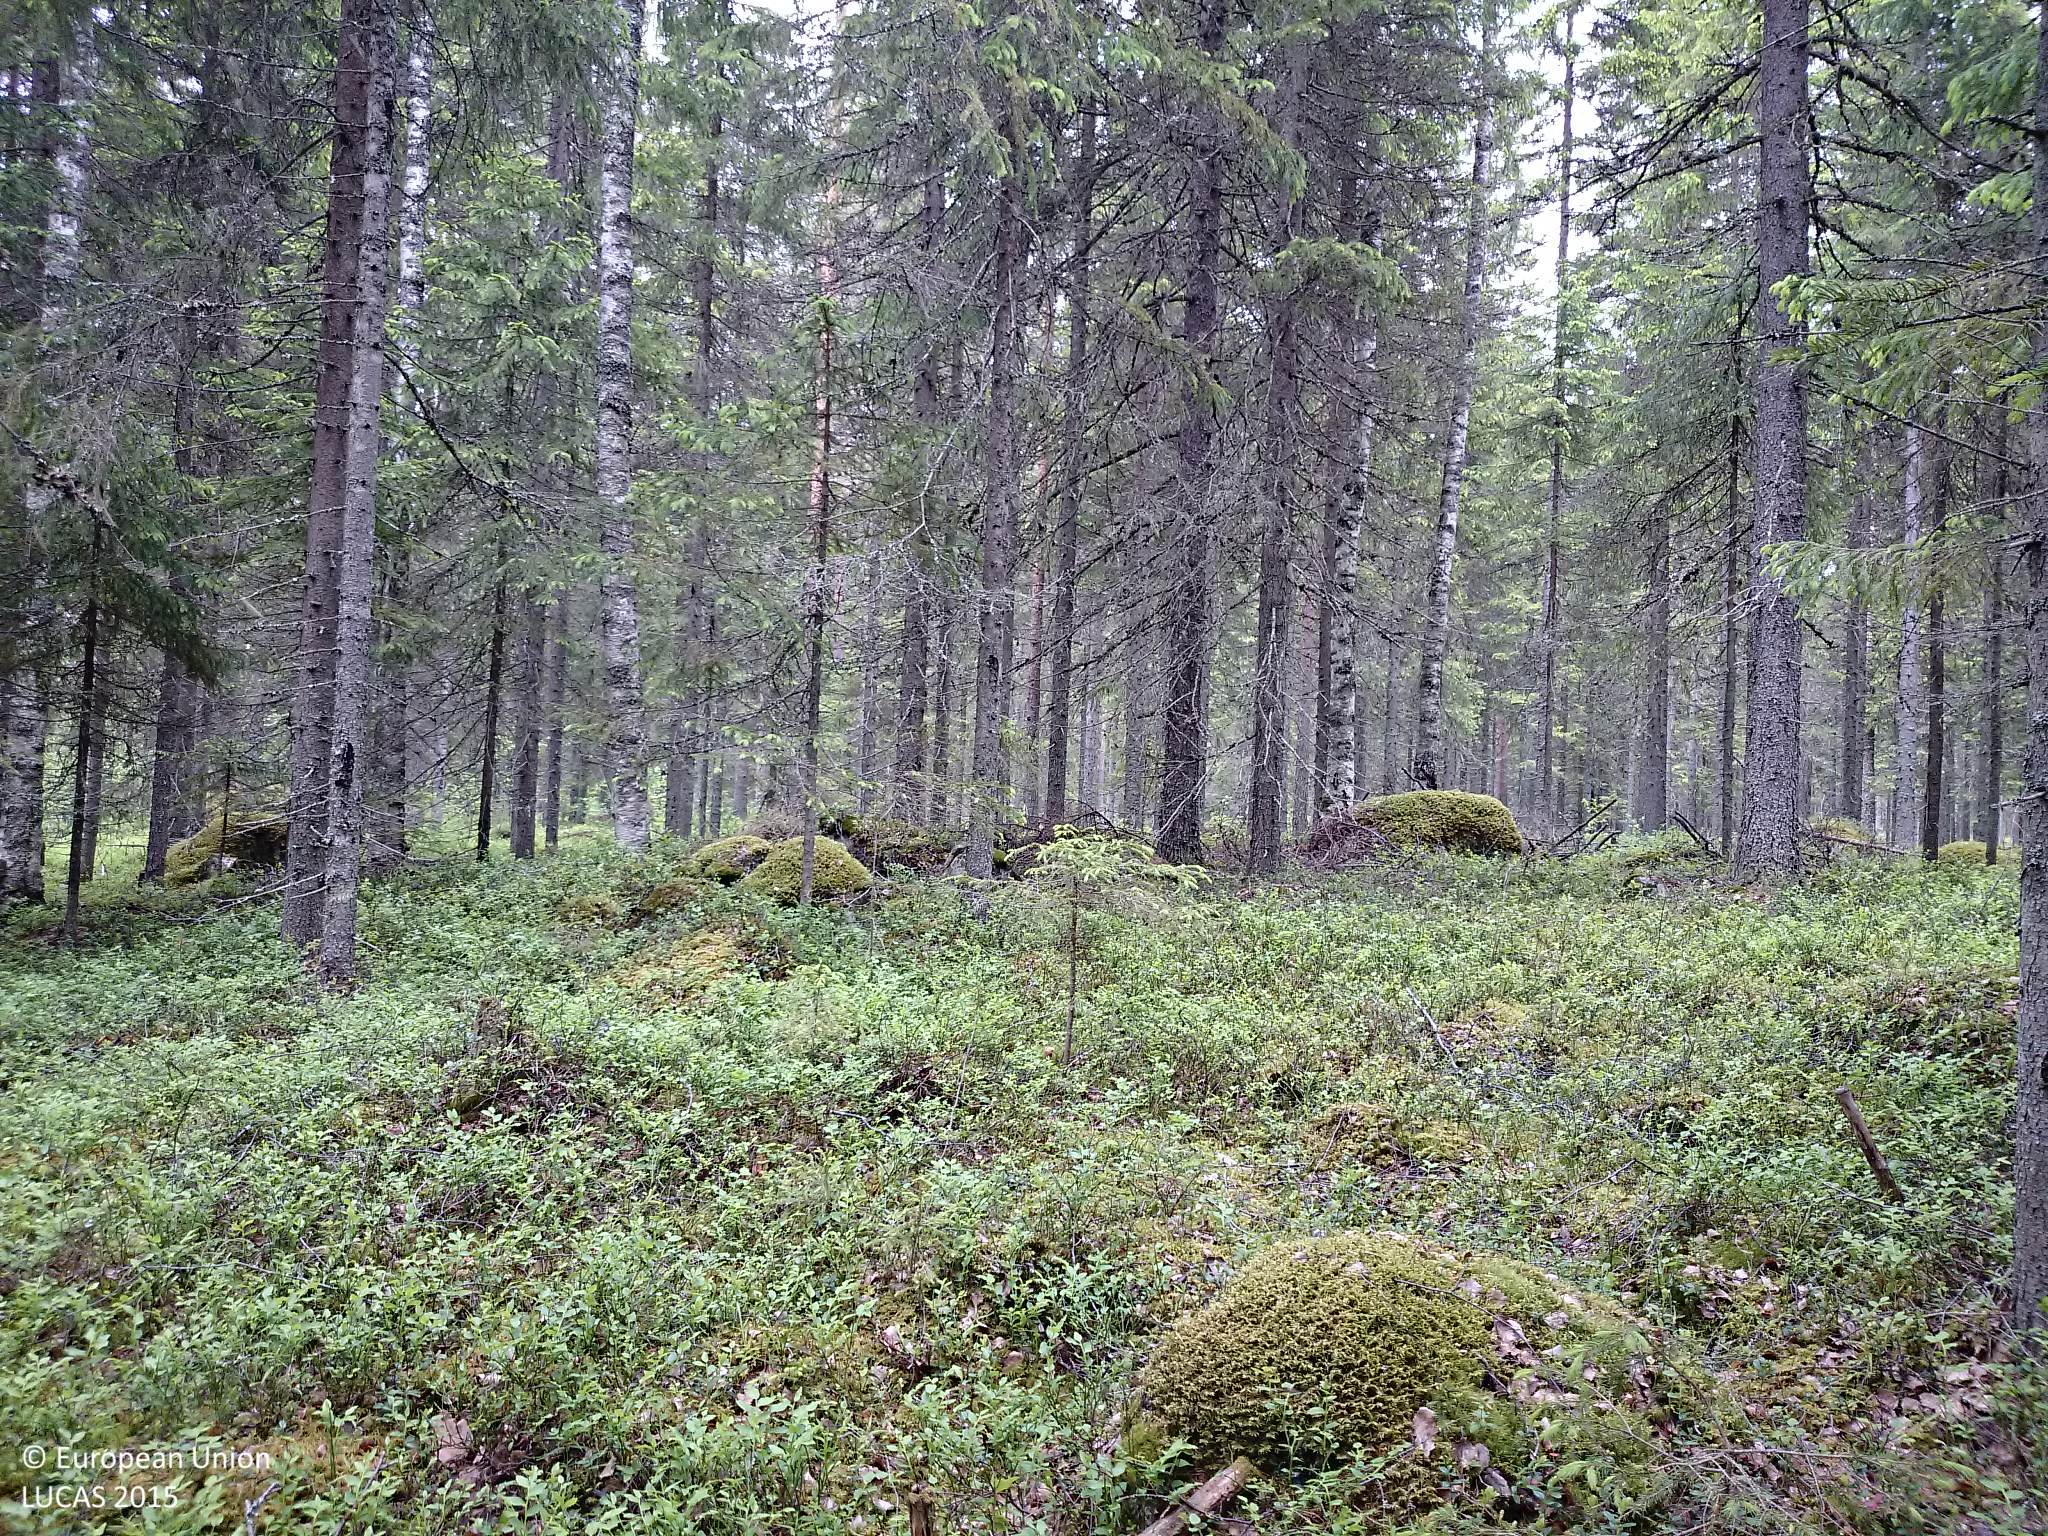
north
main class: Woodland
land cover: Spruce dominated mixed woodland
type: boreal forest
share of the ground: > 75 %
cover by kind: coniferous forest trees 60 %, broadleaved forest trees 20 %, shrubs 15 %, lichens and mosses 5 %
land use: Forestry
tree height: > 5 m
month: June
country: SE
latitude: 64.1308
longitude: 20.6430
